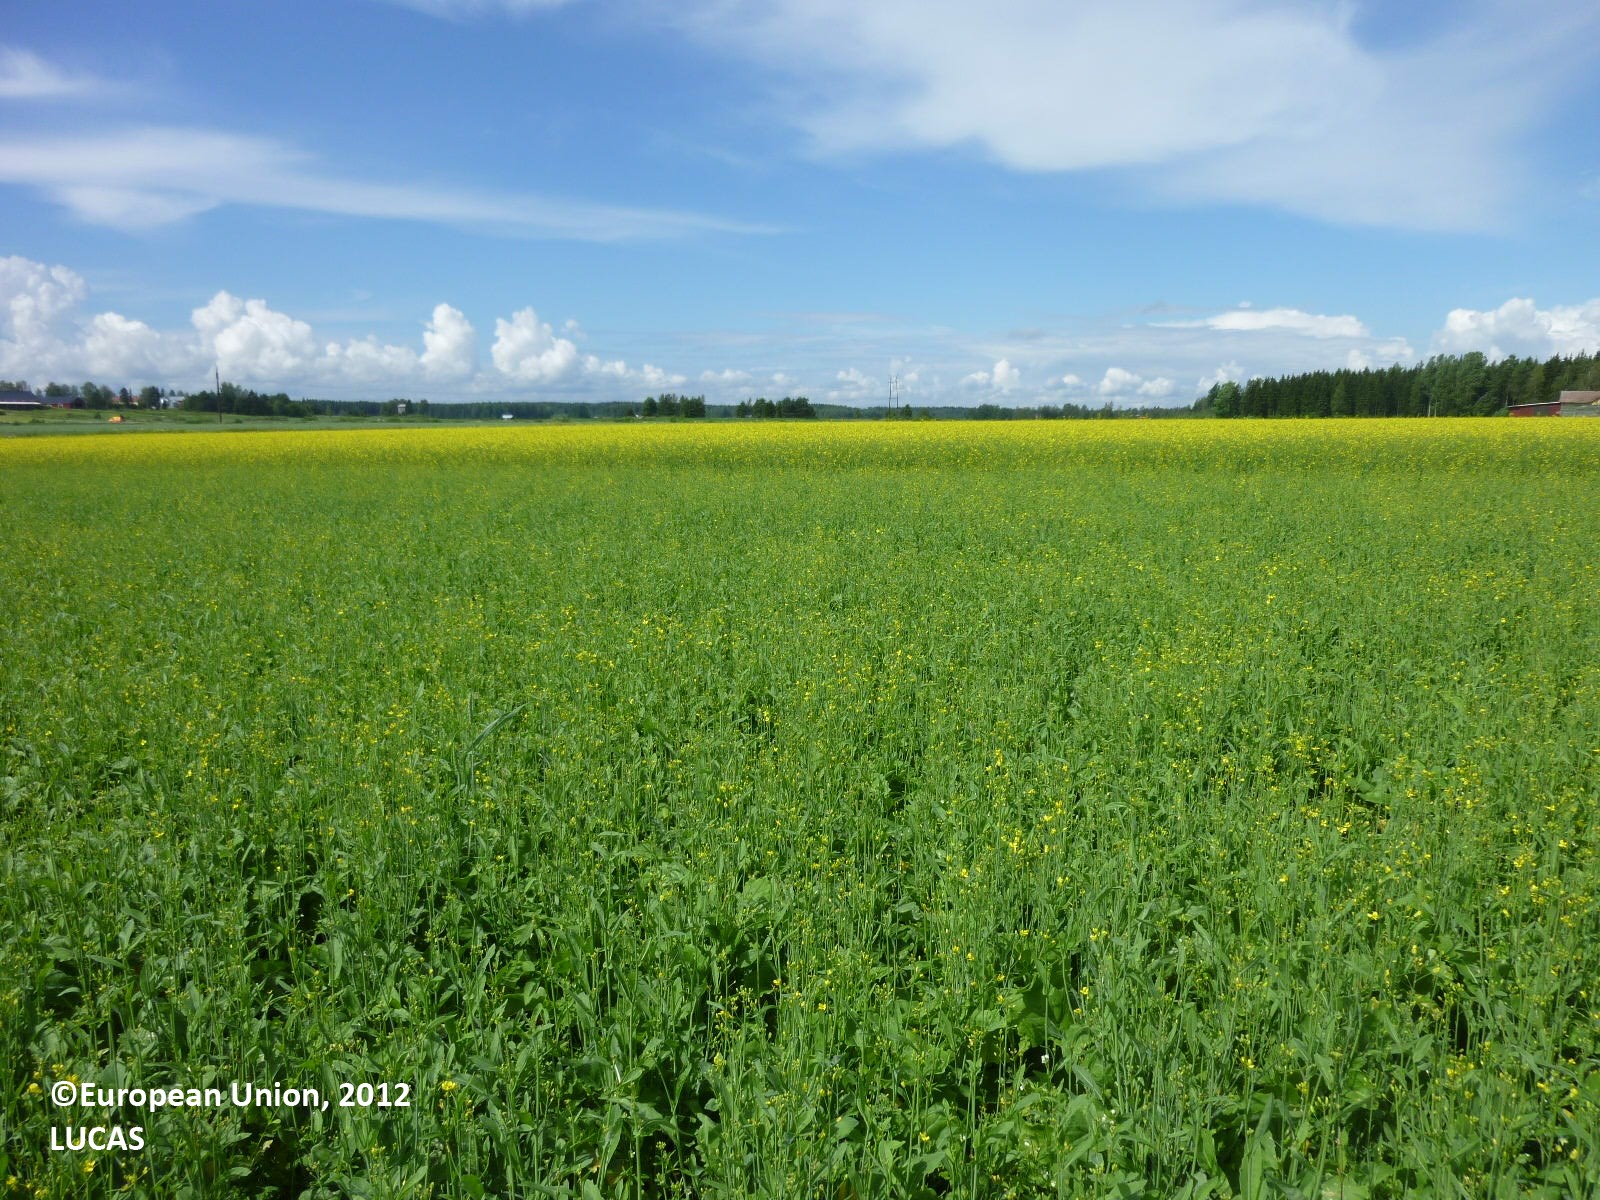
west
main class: Cropland
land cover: Common wheat
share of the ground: > 75 %
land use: Agriculture (excluding fallow land and kitchen gardens)
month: July
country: FI
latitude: 61.2471
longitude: 22.0794
